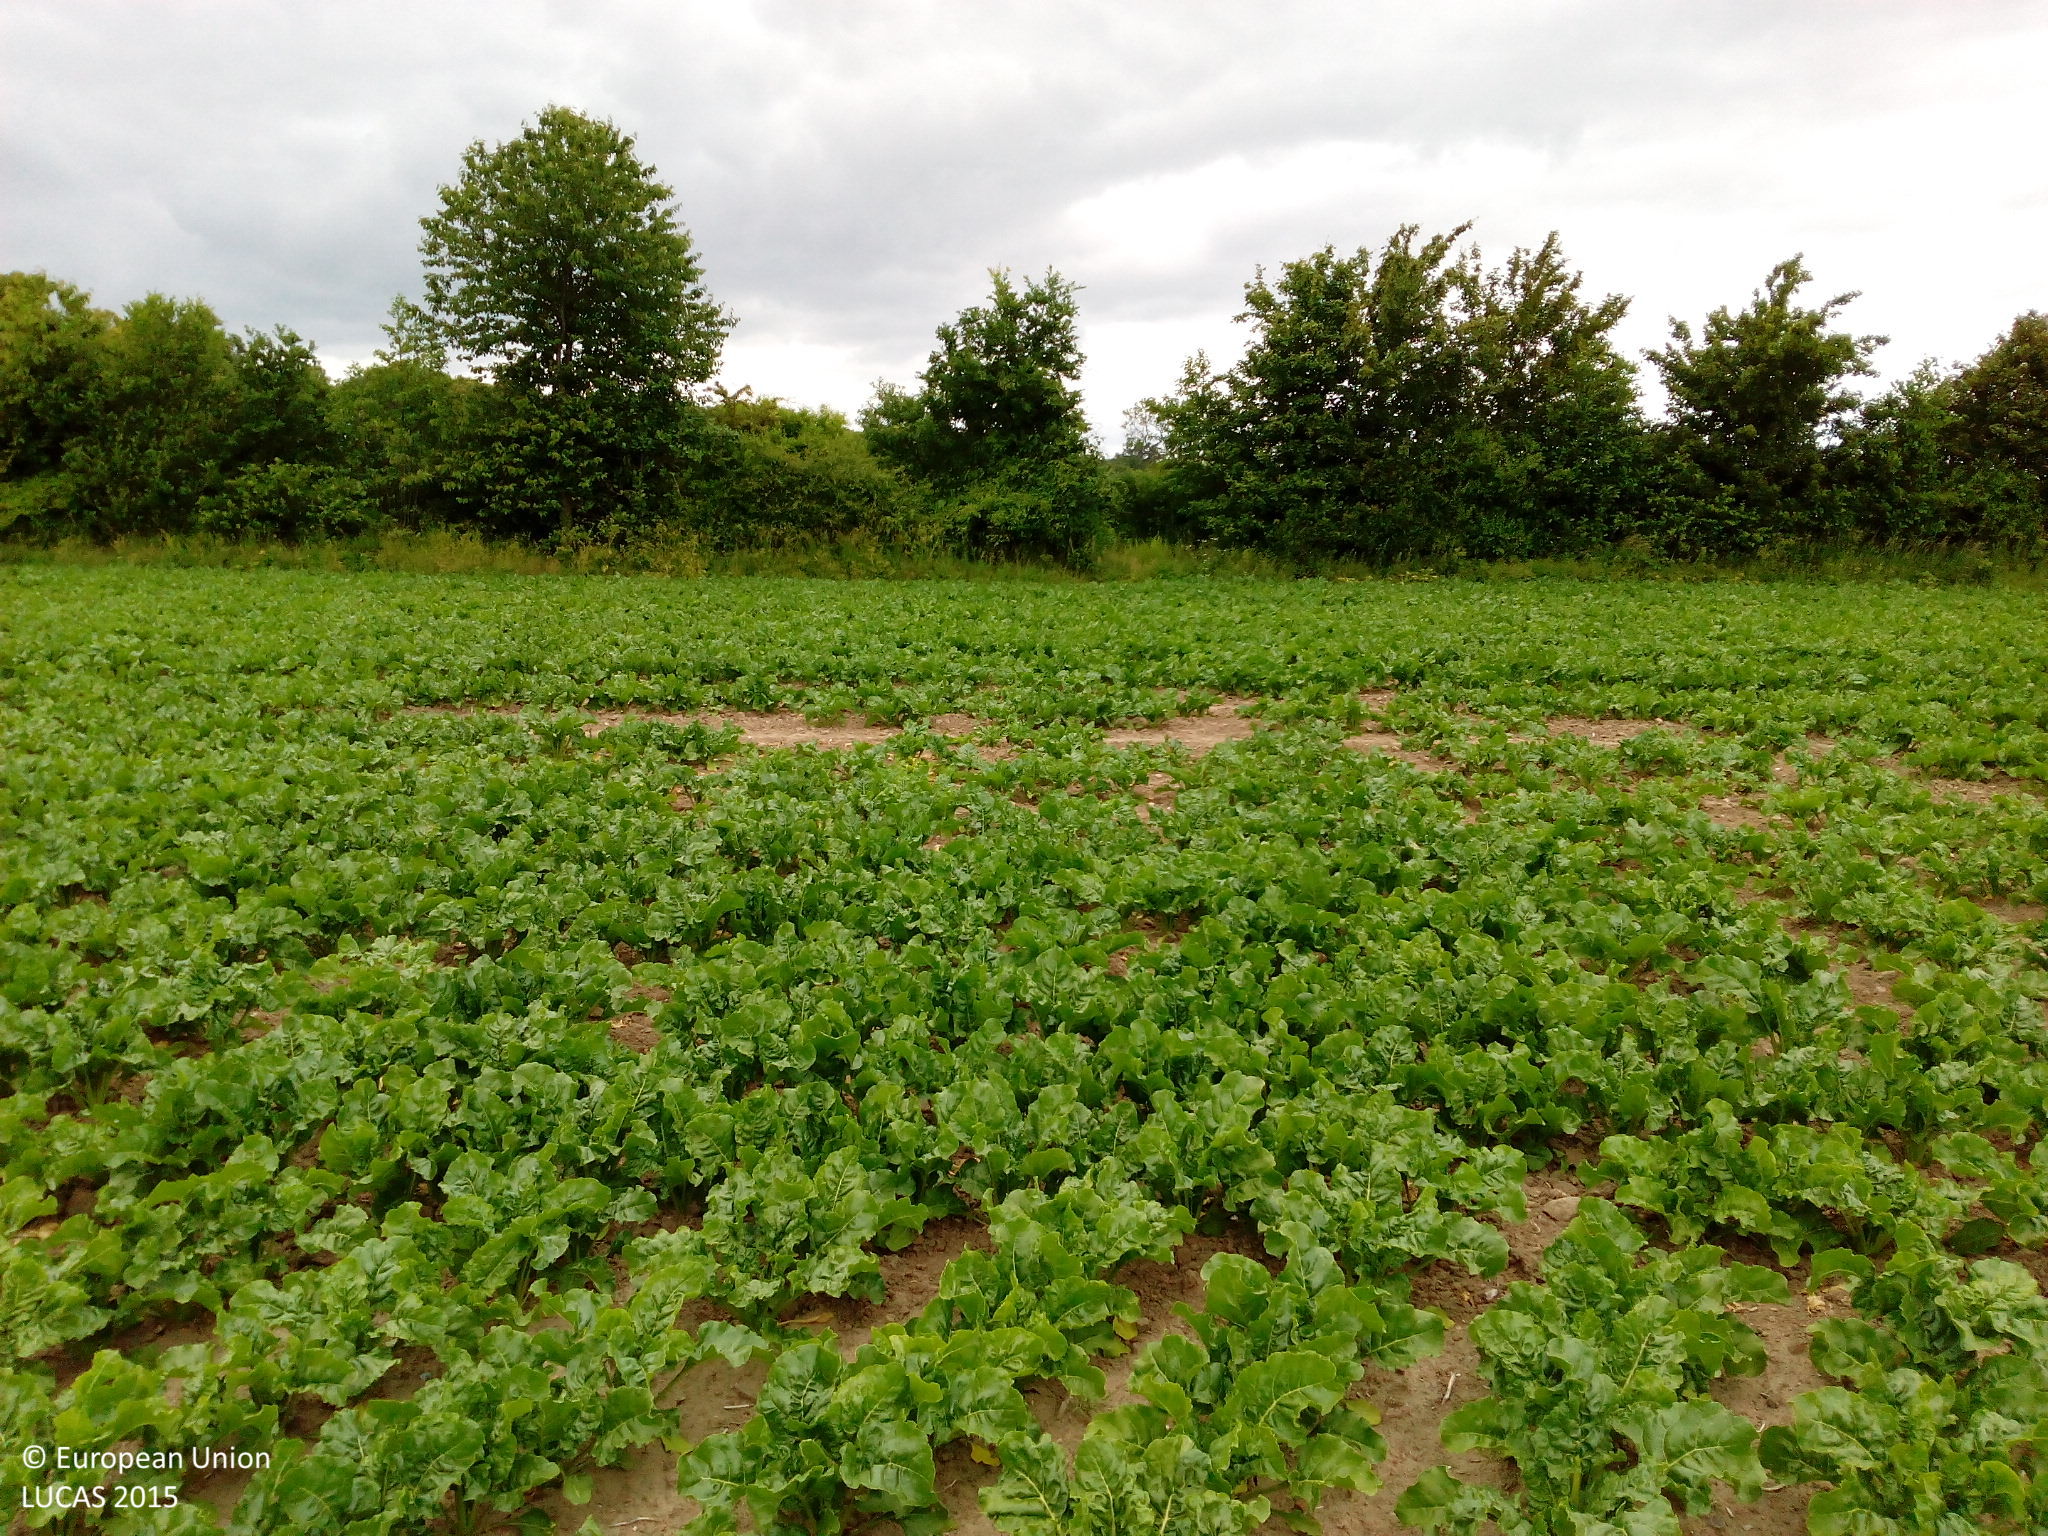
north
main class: Cropland
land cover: Sugar beet
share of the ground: 50 - 75 %
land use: Agriculture (excluding fallow land and kitchen gardens)
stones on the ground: 10 - 25 %
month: June
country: DK
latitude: 54.8294
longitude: 11.6023
